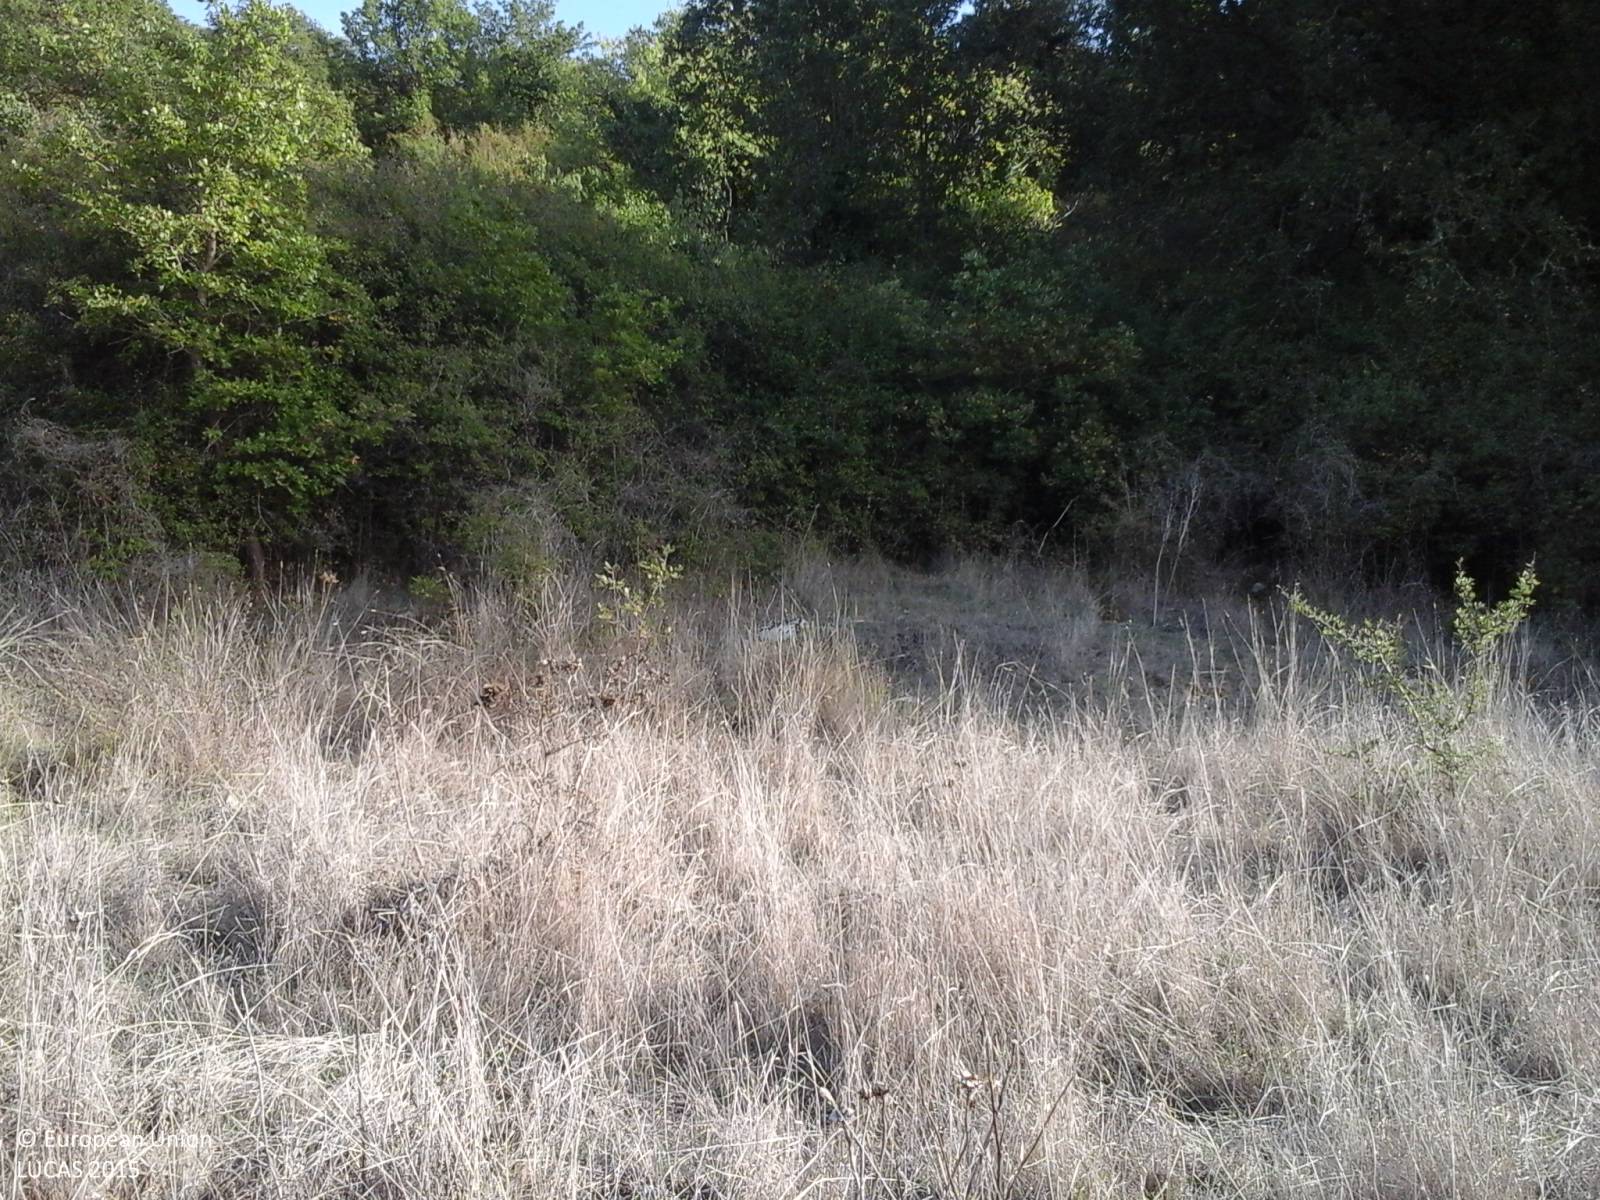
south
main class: Grassland
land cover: Grassland without tree/shrub cover
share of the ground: > 75 %
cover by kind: herbaceous plants 100 %
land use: Agriculture (excluding fallow land and kitchen gardens)
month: October
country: IT
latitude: 40.4019
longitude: 8.5815
